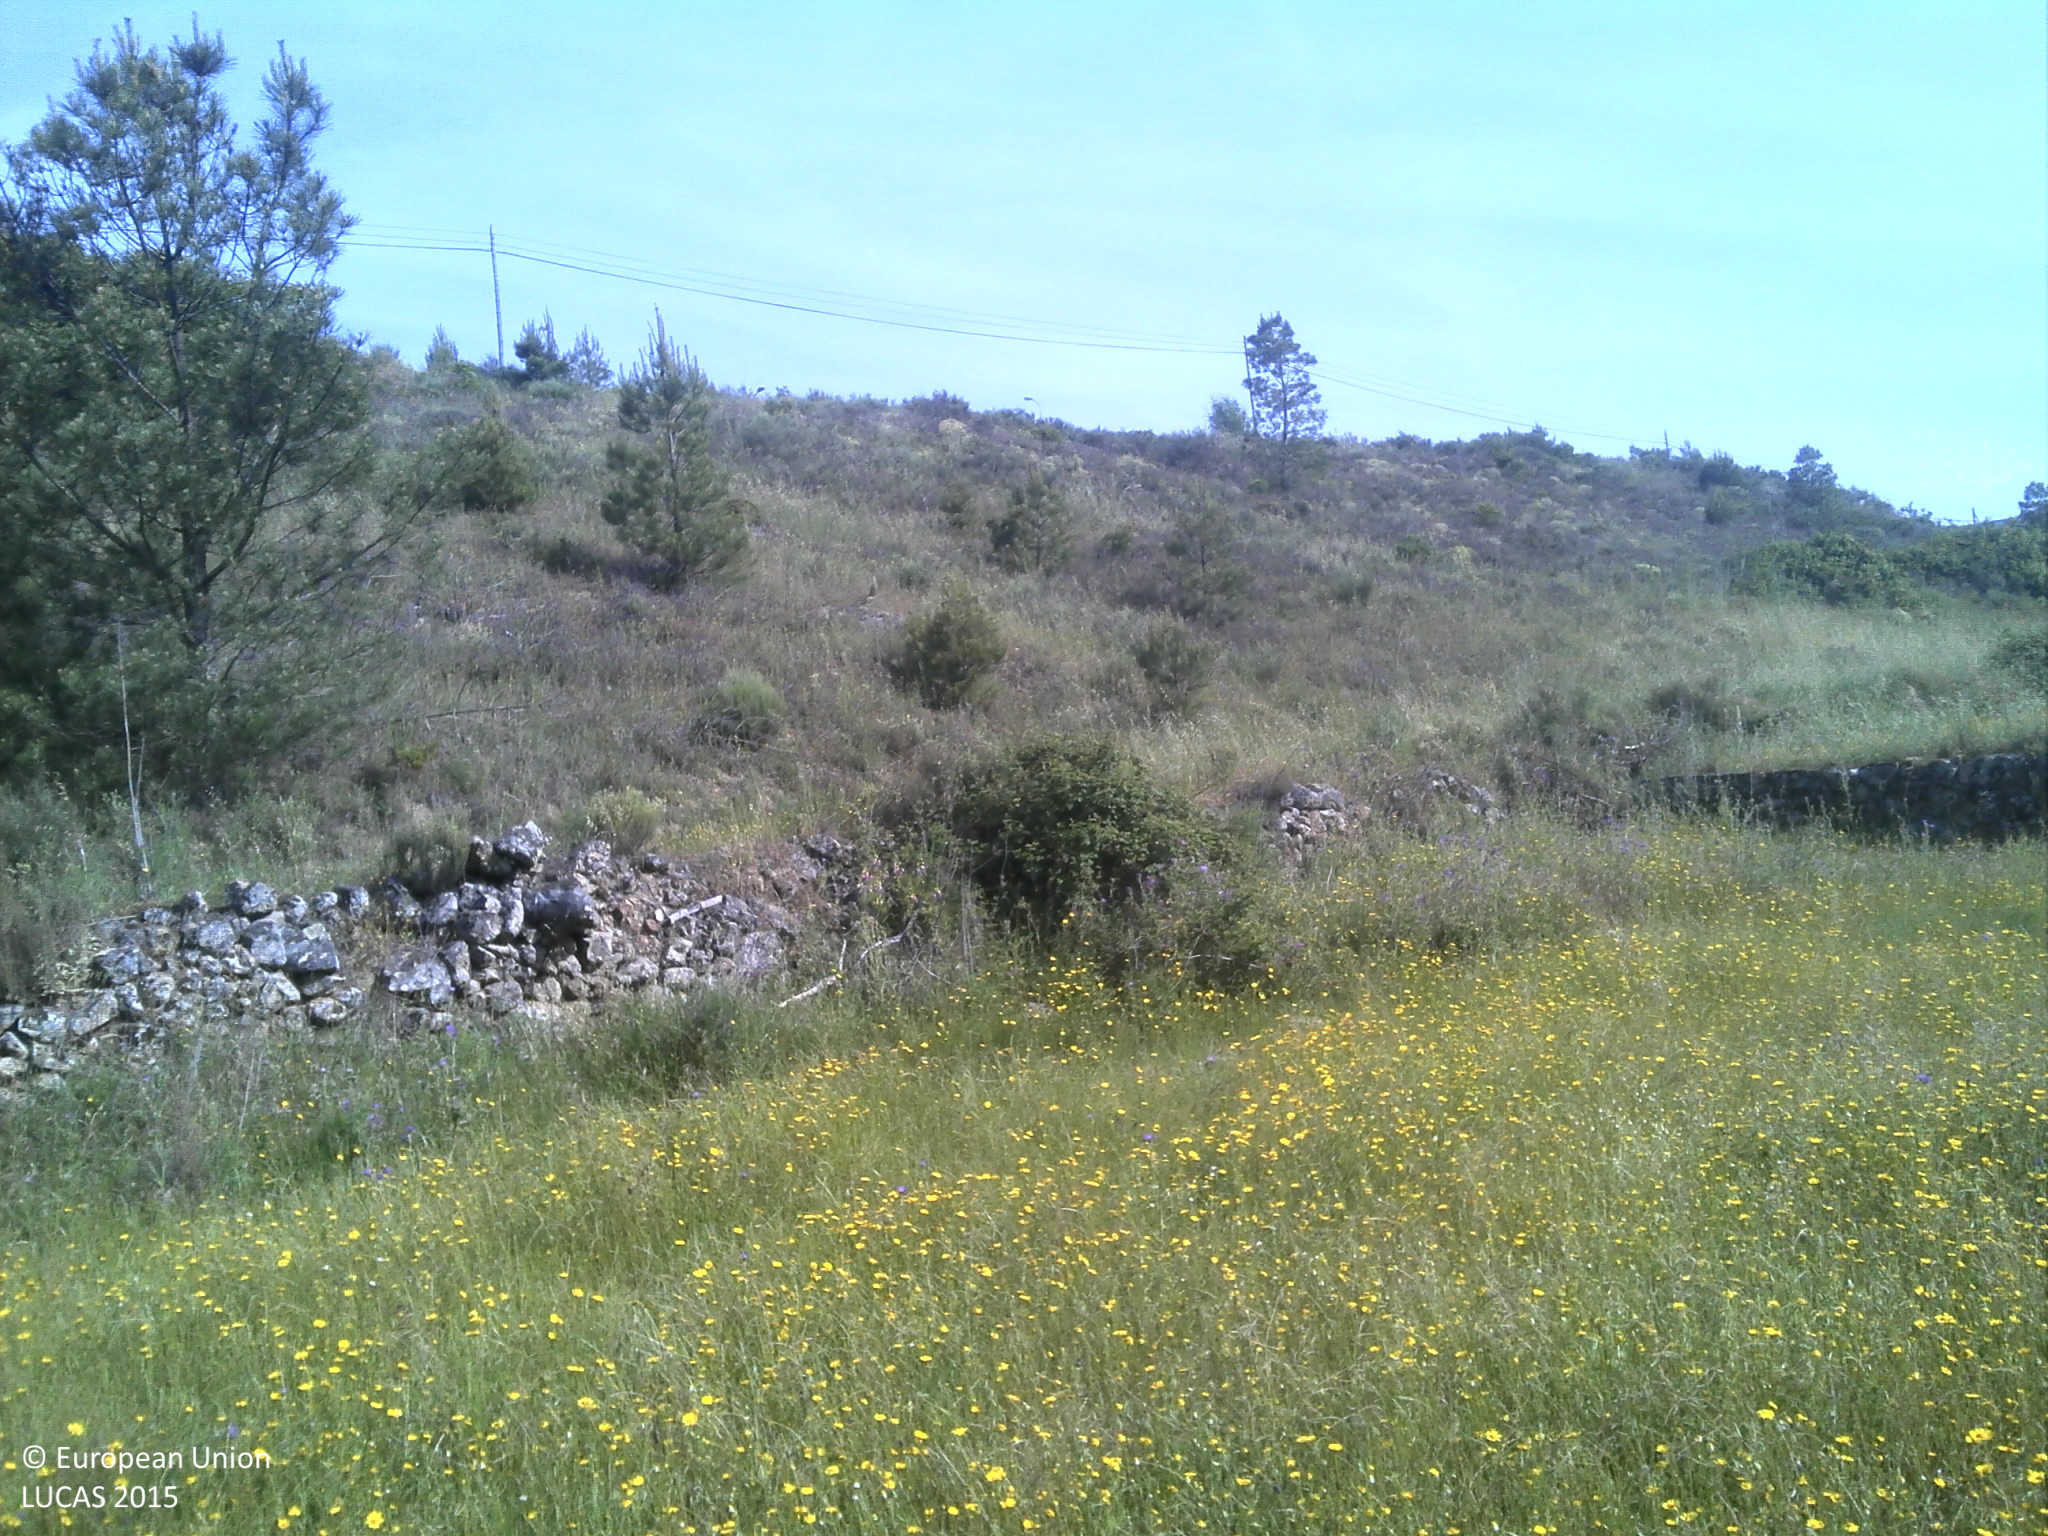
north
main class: Grassland
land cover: Grassland without tree/shrub cover
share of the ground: 50 - 75 %
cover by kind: herbaceous plants 65 %, unconsolidated bare surface 25 %
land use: Agriculture (excluding fallow land and kitchen gardens)
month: May
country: PT
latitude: 40.6173
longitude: -7.4038
